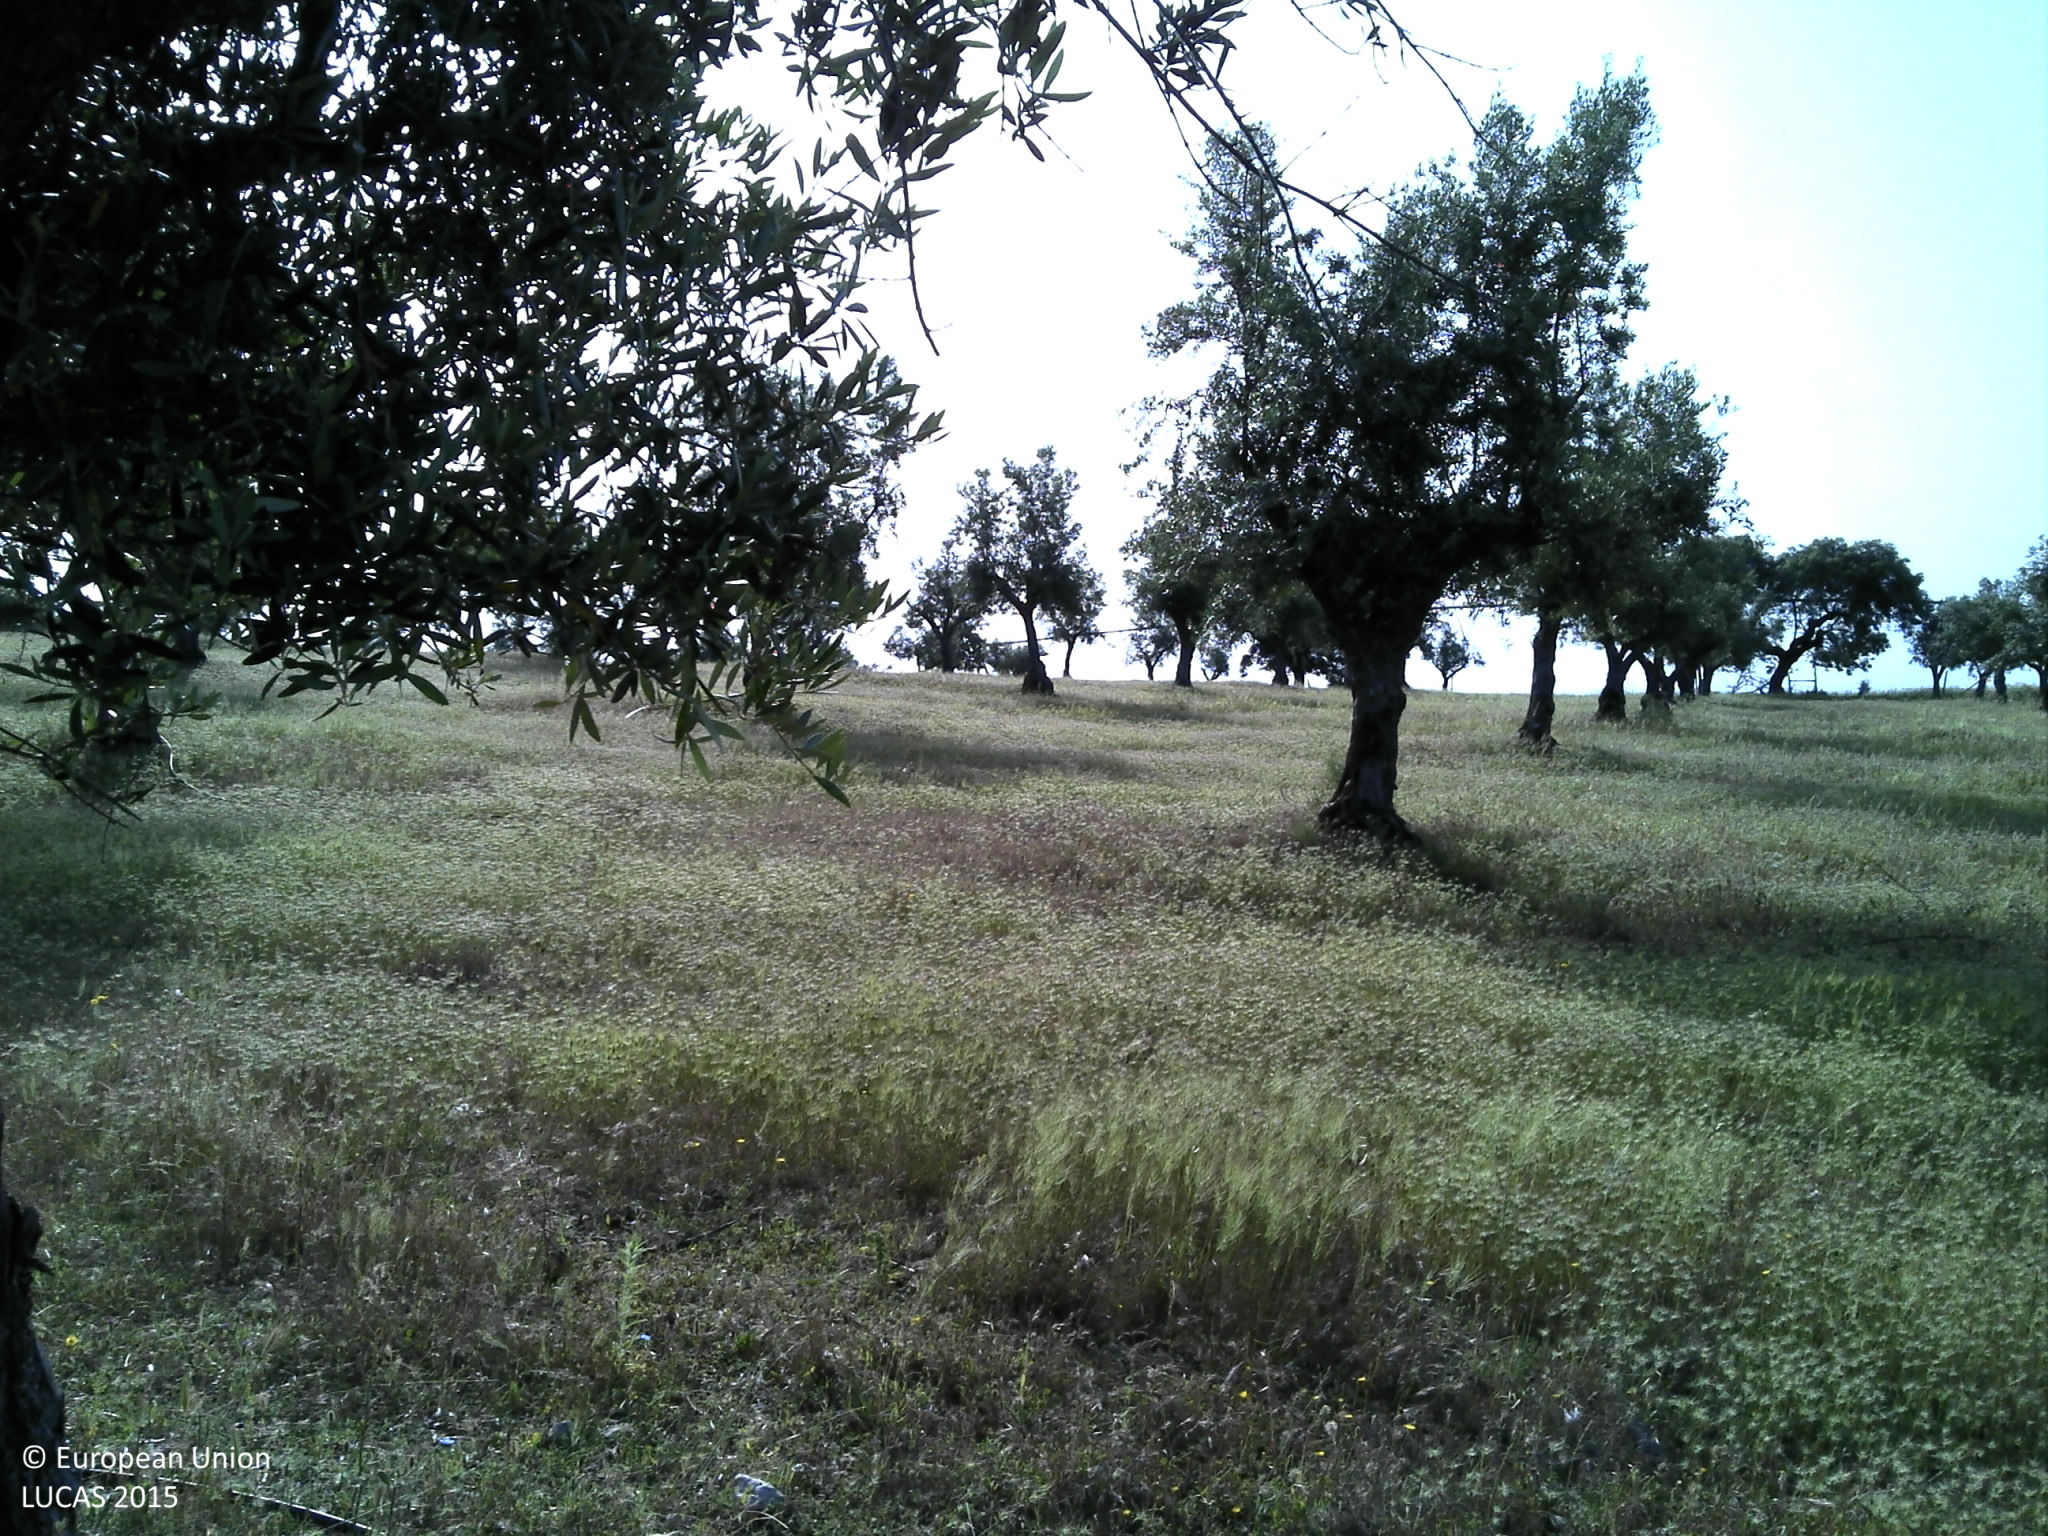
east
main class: Cropland
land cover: Olive groves
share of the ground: 25 - 50 %
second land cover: Grassland without tree/shrub cover
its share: 50 - 75 %
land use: Agriculture (excluding fallow land and kitchen gardens)
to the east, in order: Olive groves; Grassland without tree/shrub cover; Tracks; Olive groves; Fences; Oats
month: May
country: PT
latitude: 39.0136
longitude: -7.7958
